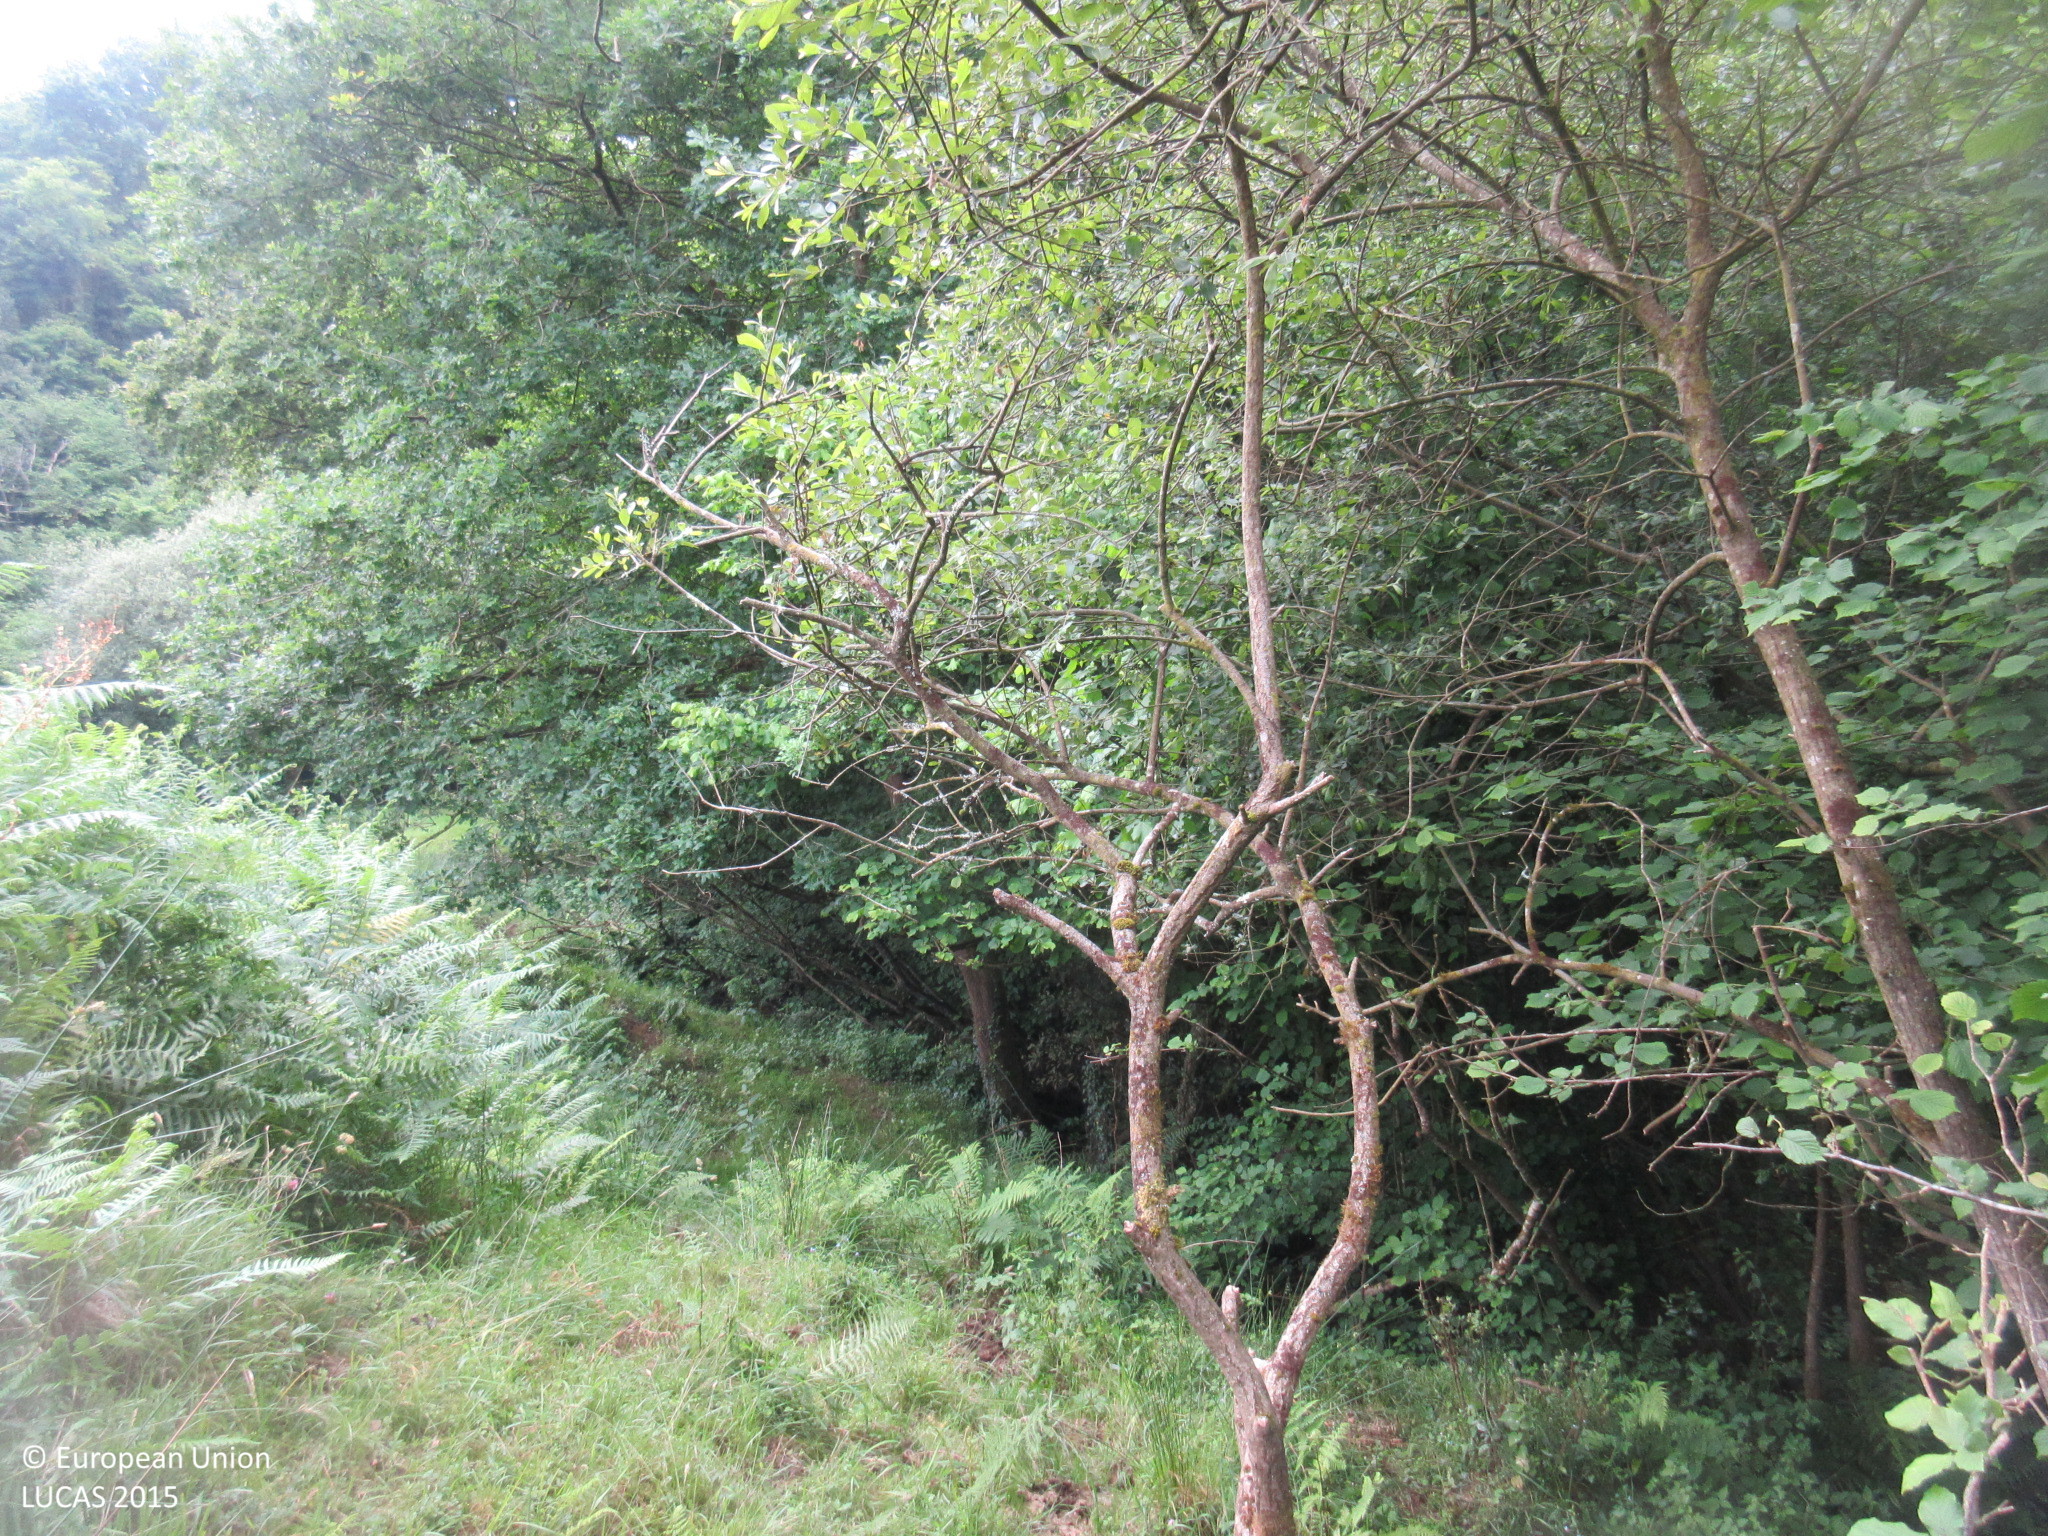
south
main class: Grassland
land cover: Grassland without tree/shrub cover
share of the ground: > 75 %
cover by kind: herbaceous plants 95 %, shrubs 5 %
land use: Agriculture (excluding fallow land and kitchen gardens)
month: June
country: ES
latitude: 43.3805
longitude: -4.1124
